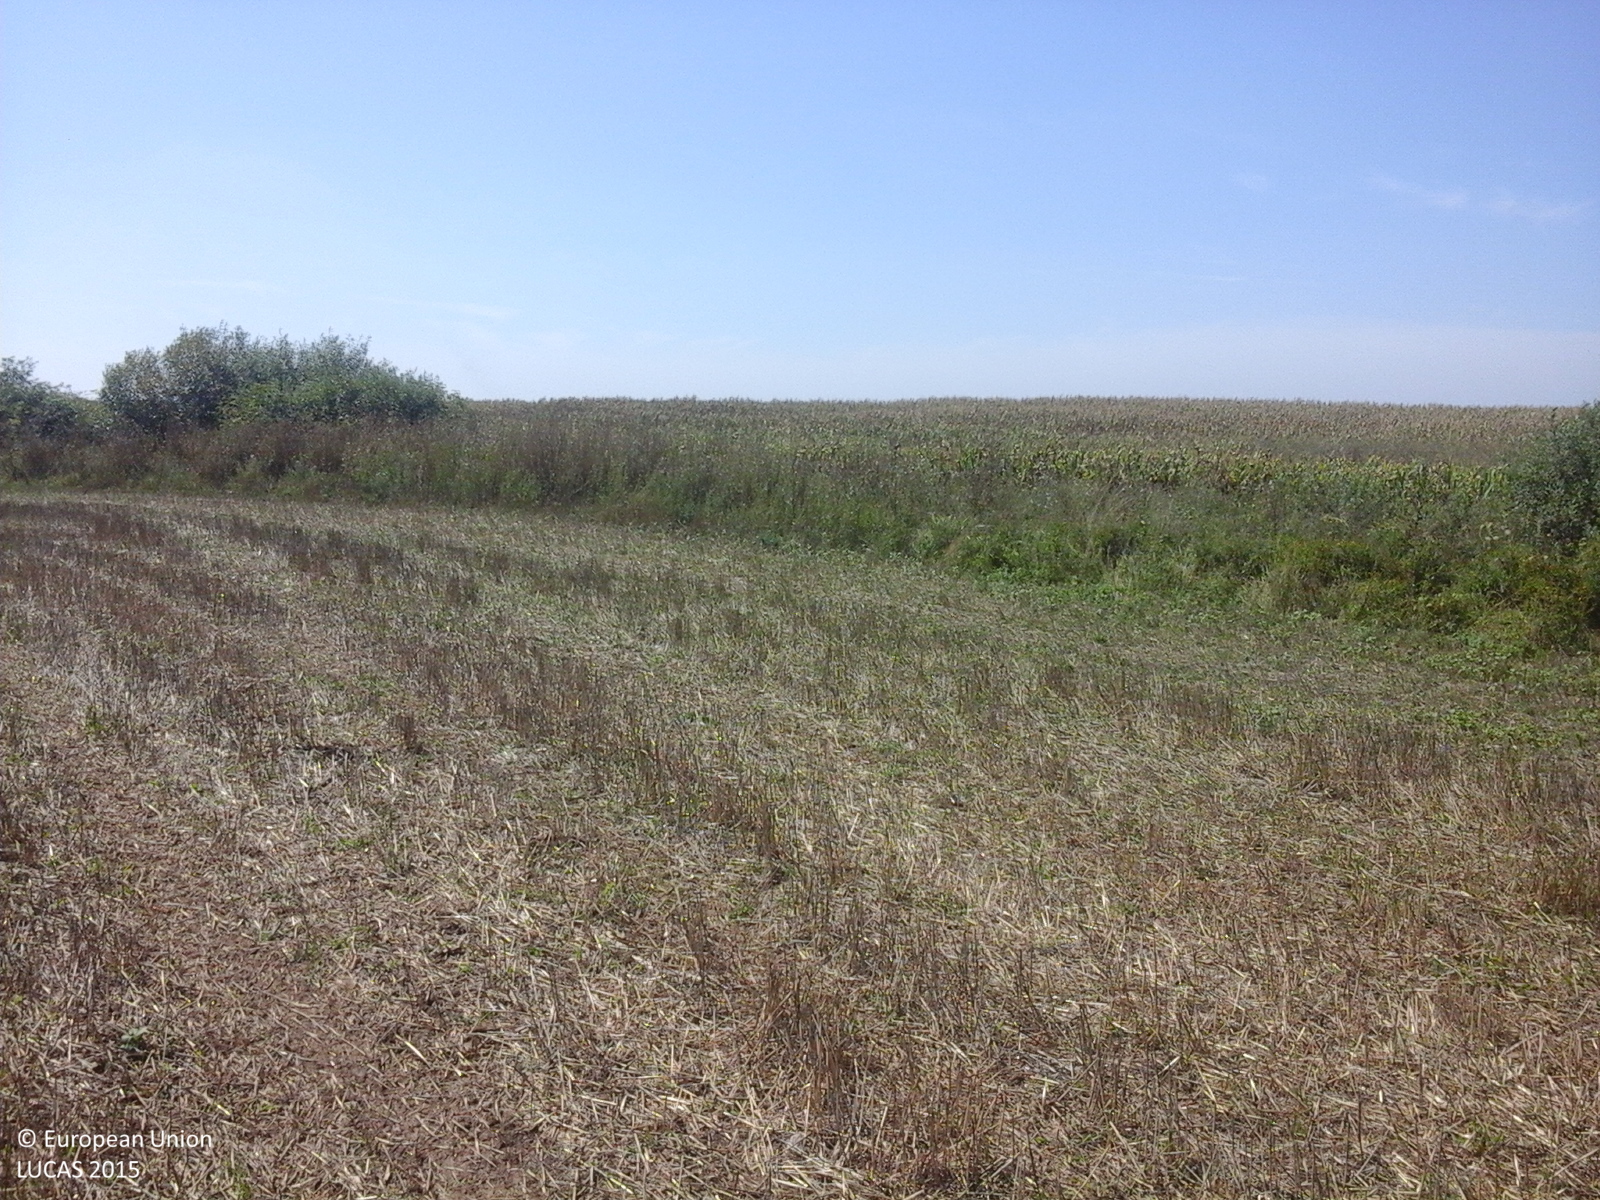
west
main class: Cropland
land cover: Common wheat
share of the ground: 50 - 75 %
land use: Agriculture (excluding fallow land and kitchen gardens)
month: August
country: RO
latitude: 45.9671
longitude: 21.1418
